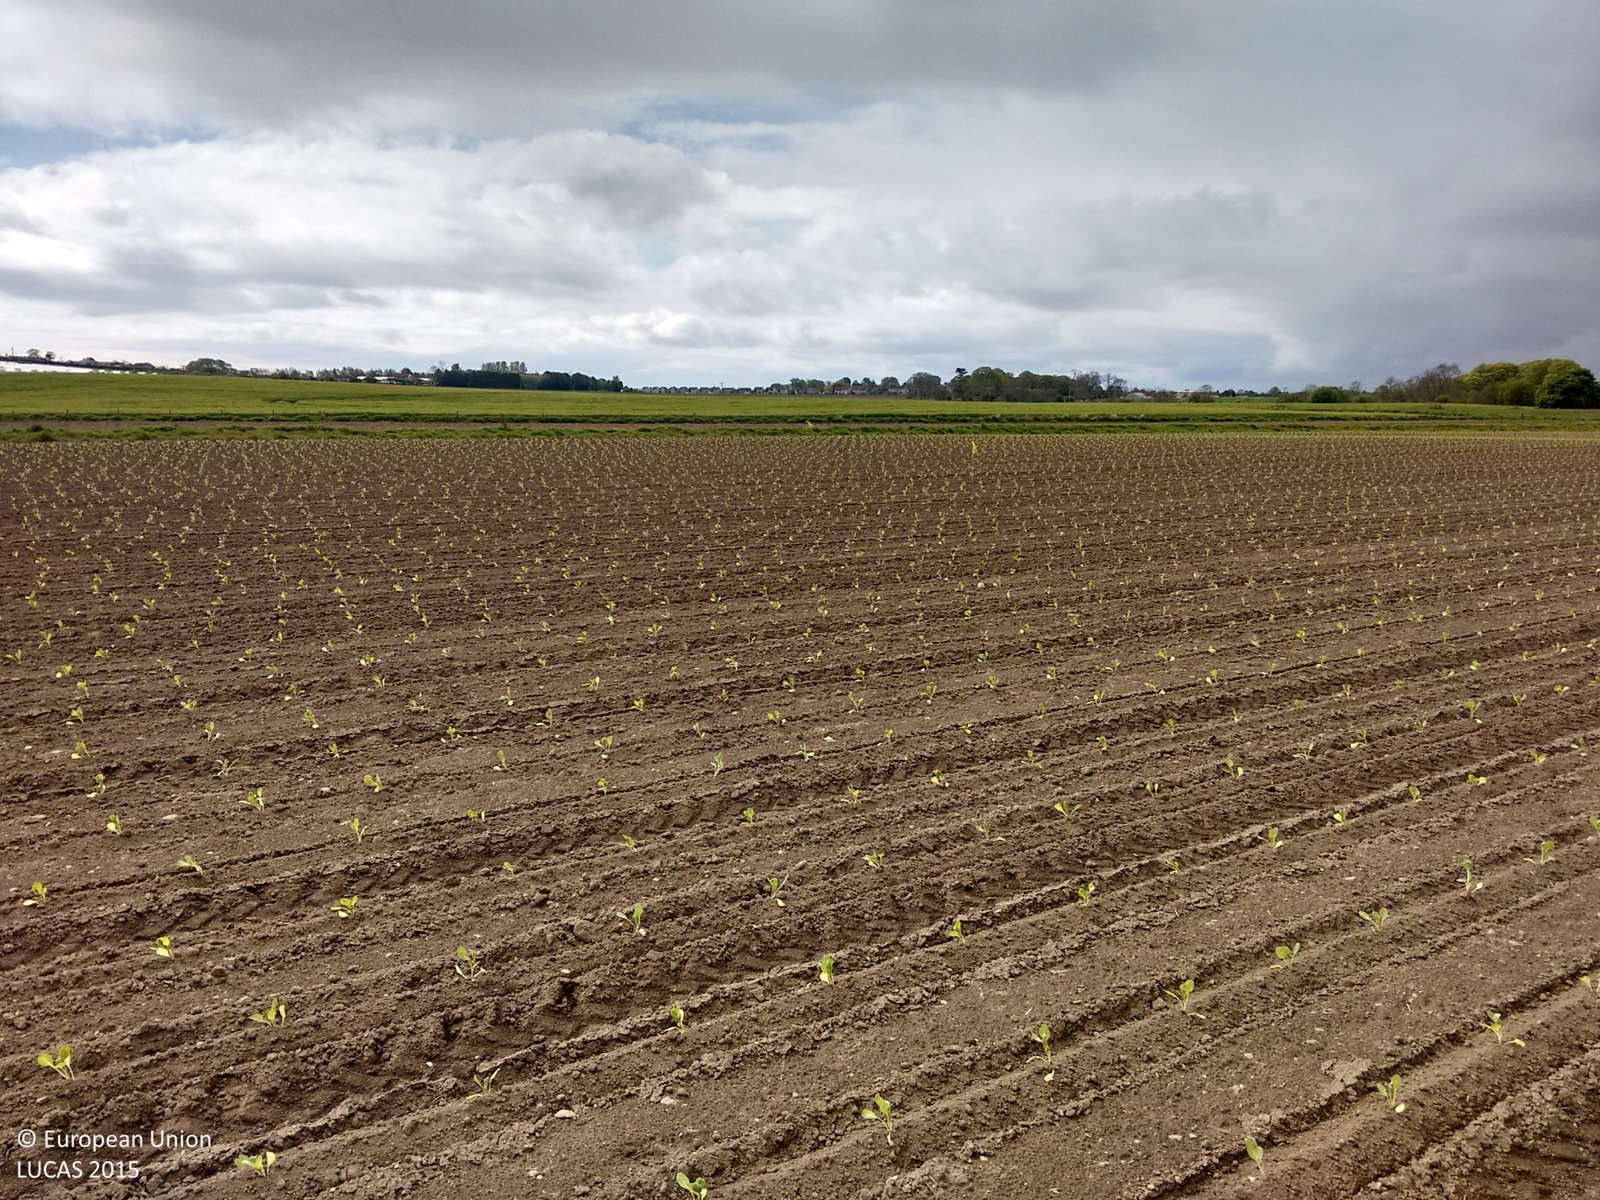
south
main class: Cropland
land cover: Other fresh vegetables
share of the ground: < 10 %
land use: Agriculture (excluding fallow land and kitchen gardens)
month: May
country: GB
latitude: 56.5862
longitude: -2.5793
